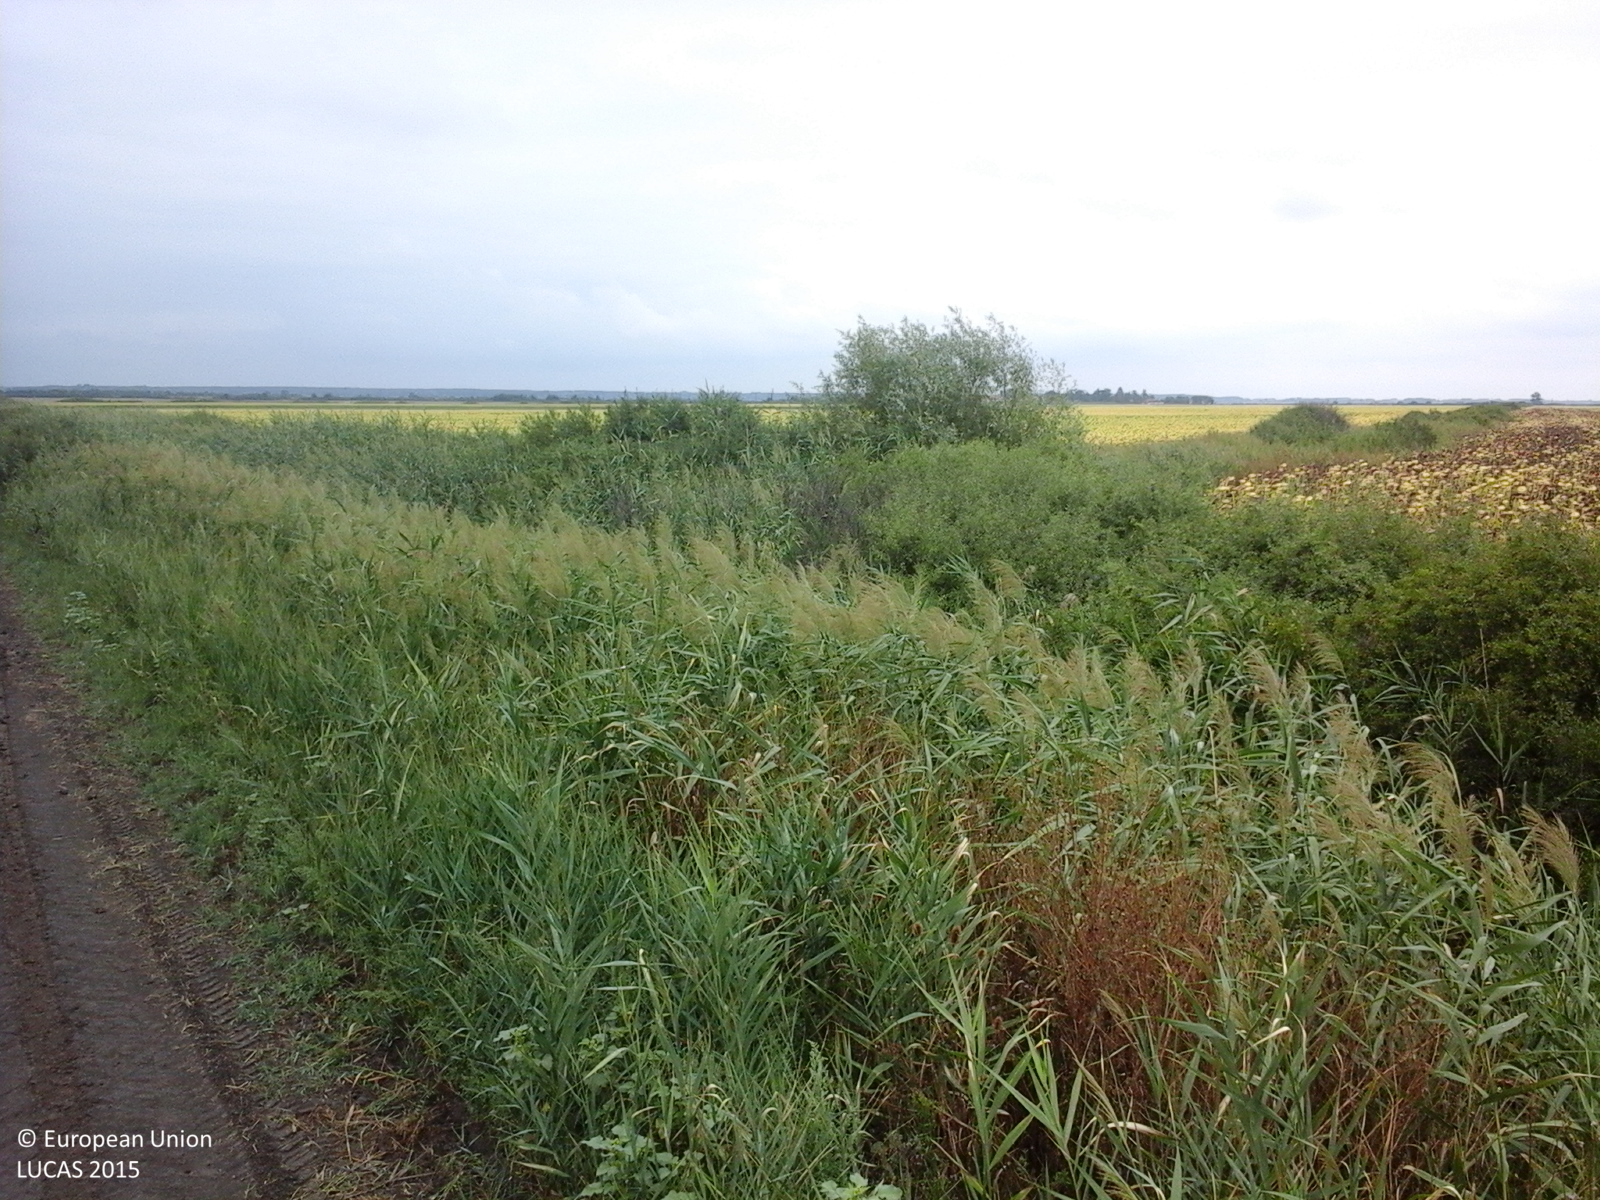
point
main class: Cropland
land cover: Sunflower
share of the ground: > 75 %
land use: Agriculture (excluding fallow land and kitchen gardens)
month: August
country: RO
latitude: 46.1241
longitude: 20.4942
